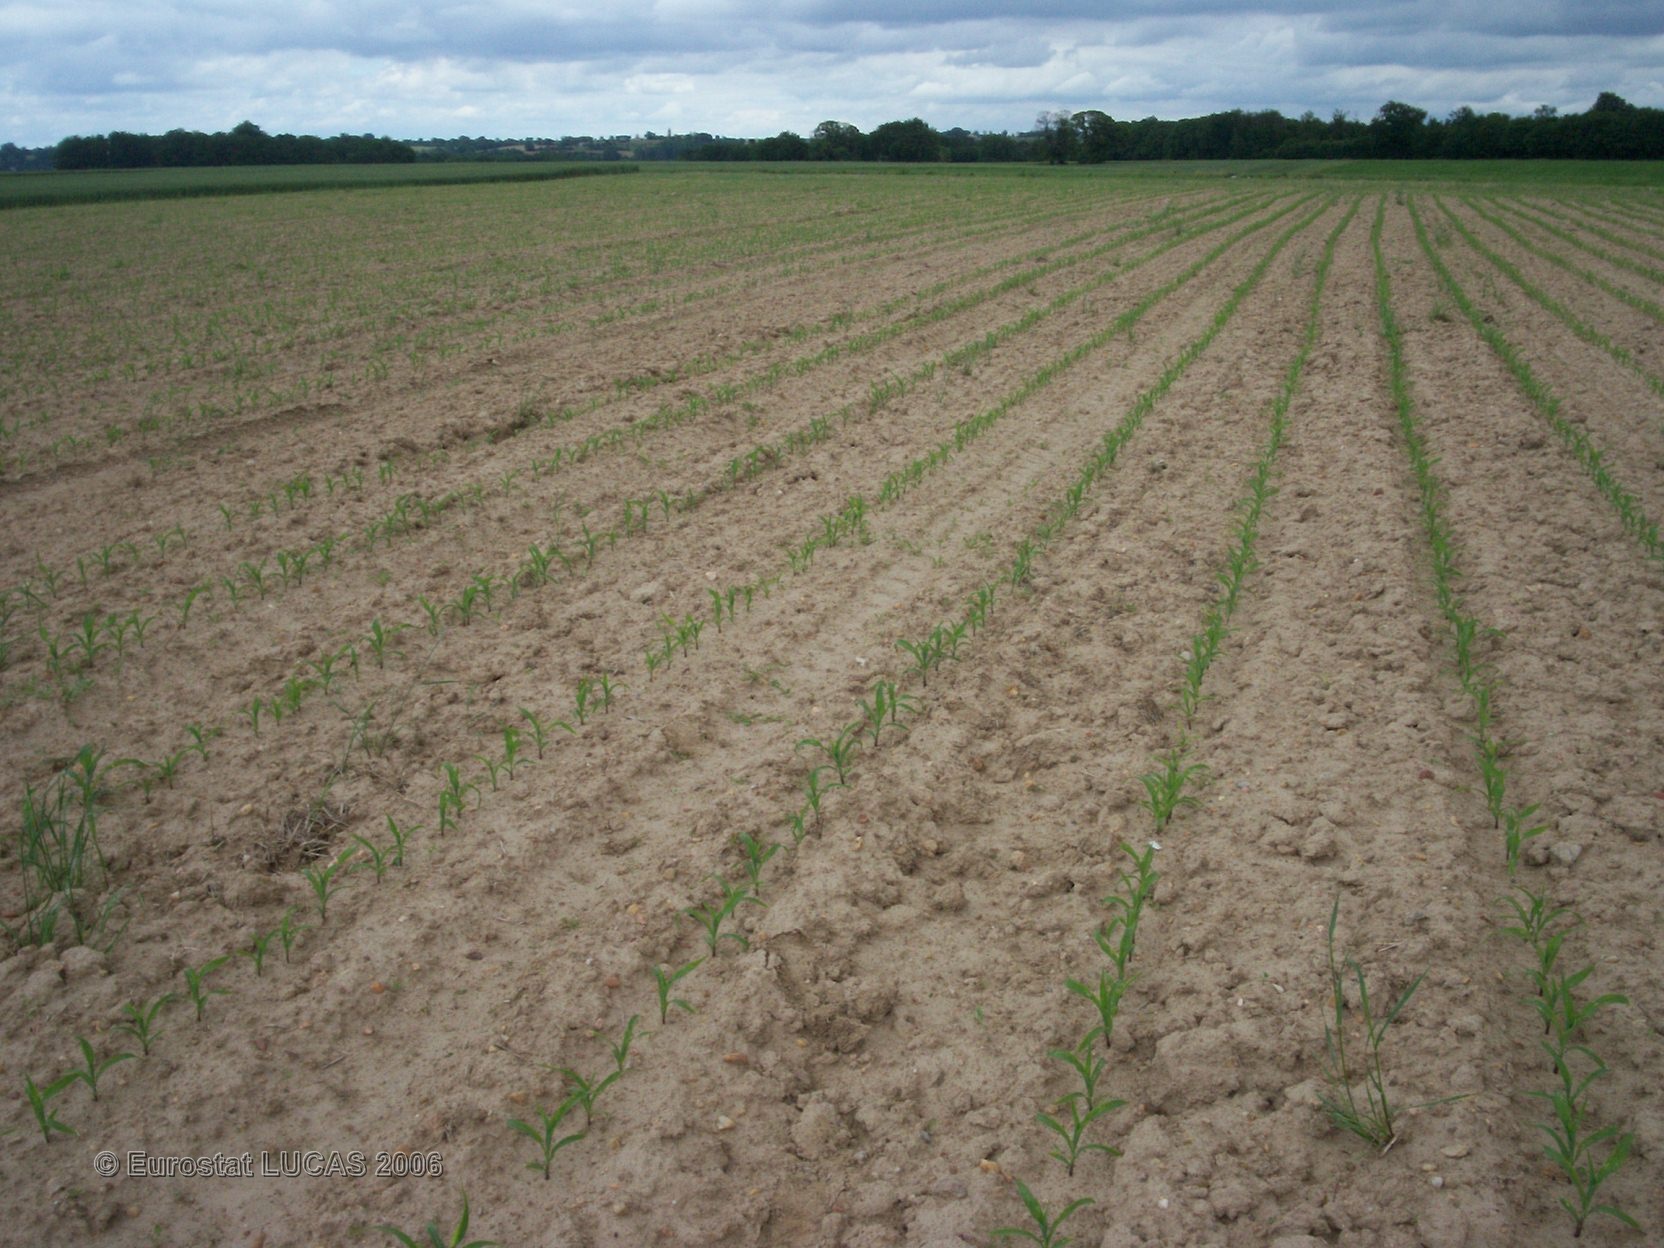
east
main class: Cropland
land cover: Maize
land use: Agriculture (excluding fallow land and kitchen gardens)
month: May
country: FR
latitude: 46.6401
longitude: 0.5635
